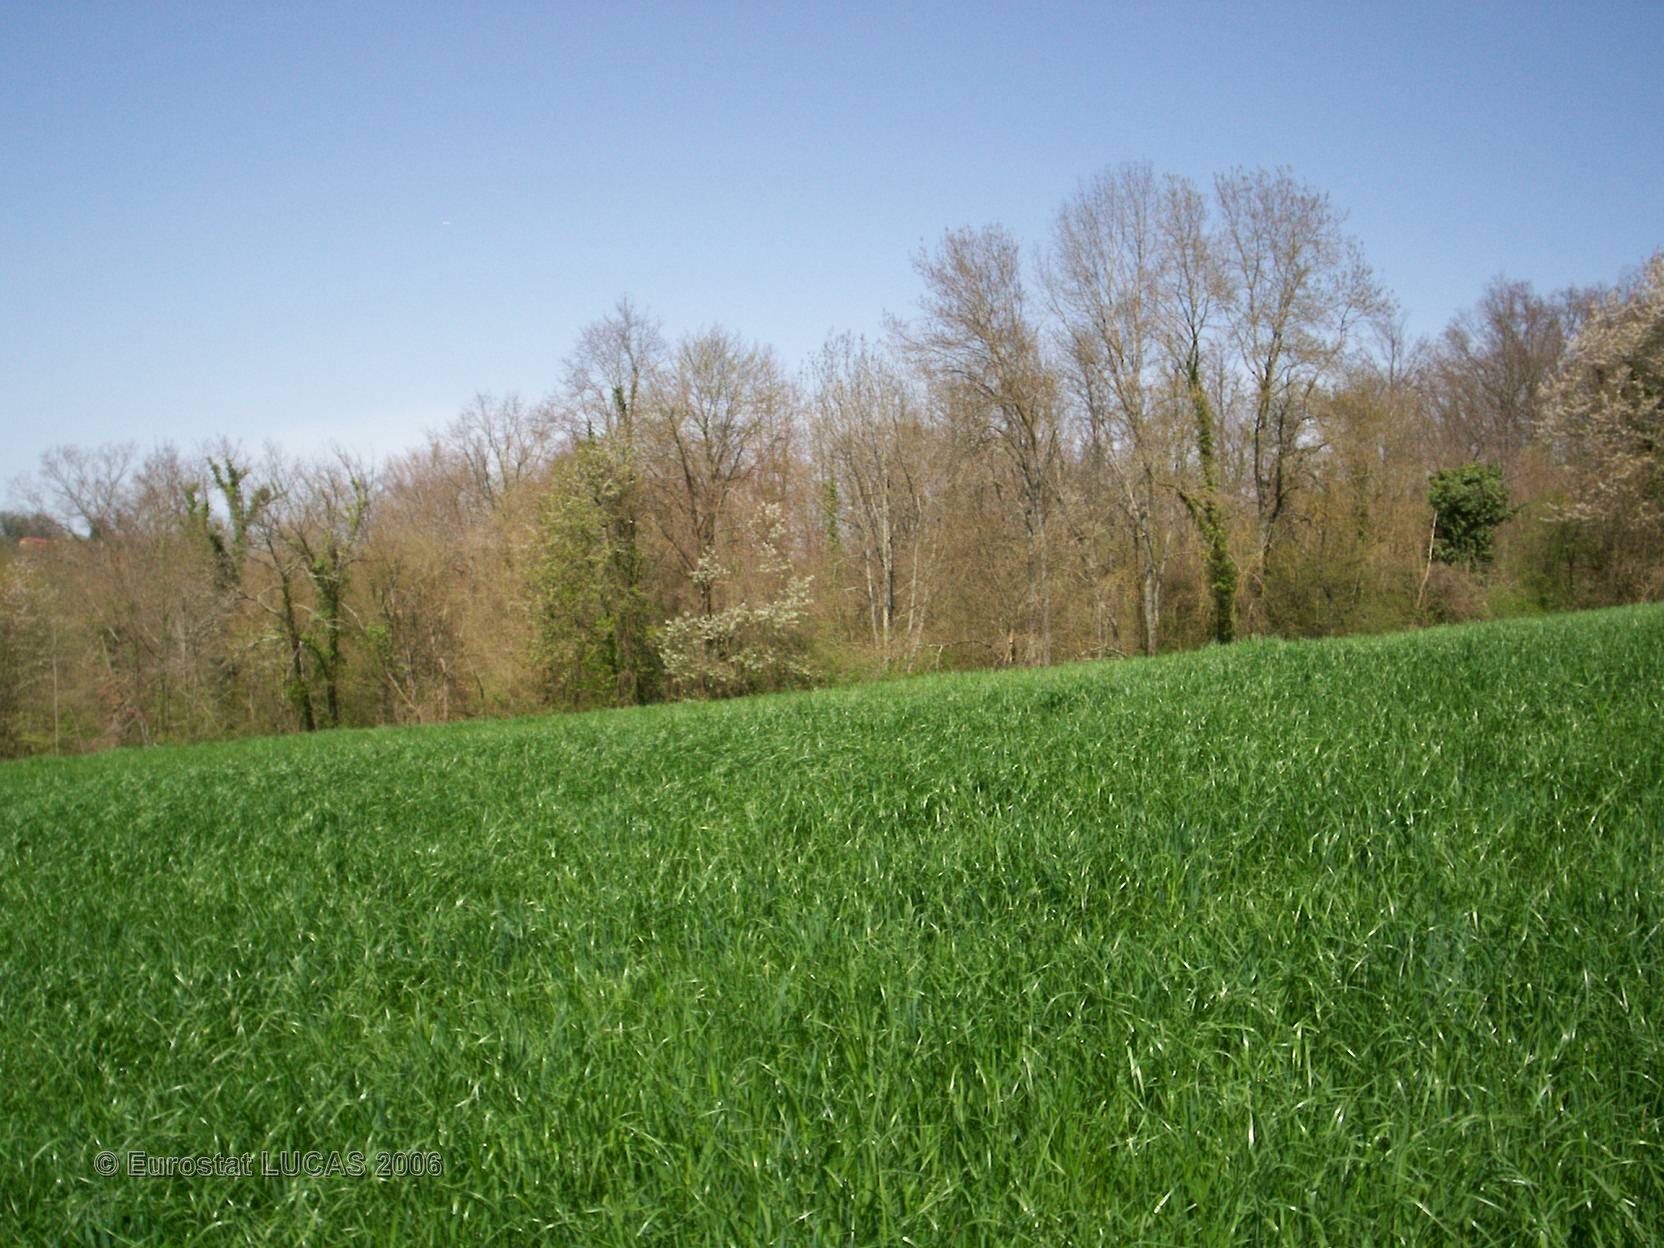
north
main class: Grassland
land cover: Grassland without tree/shrub cover
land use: Agriculture (excluding fallow land and kitchen gardens)
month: April
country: FR
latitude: 43.4006
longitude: 0.2551
